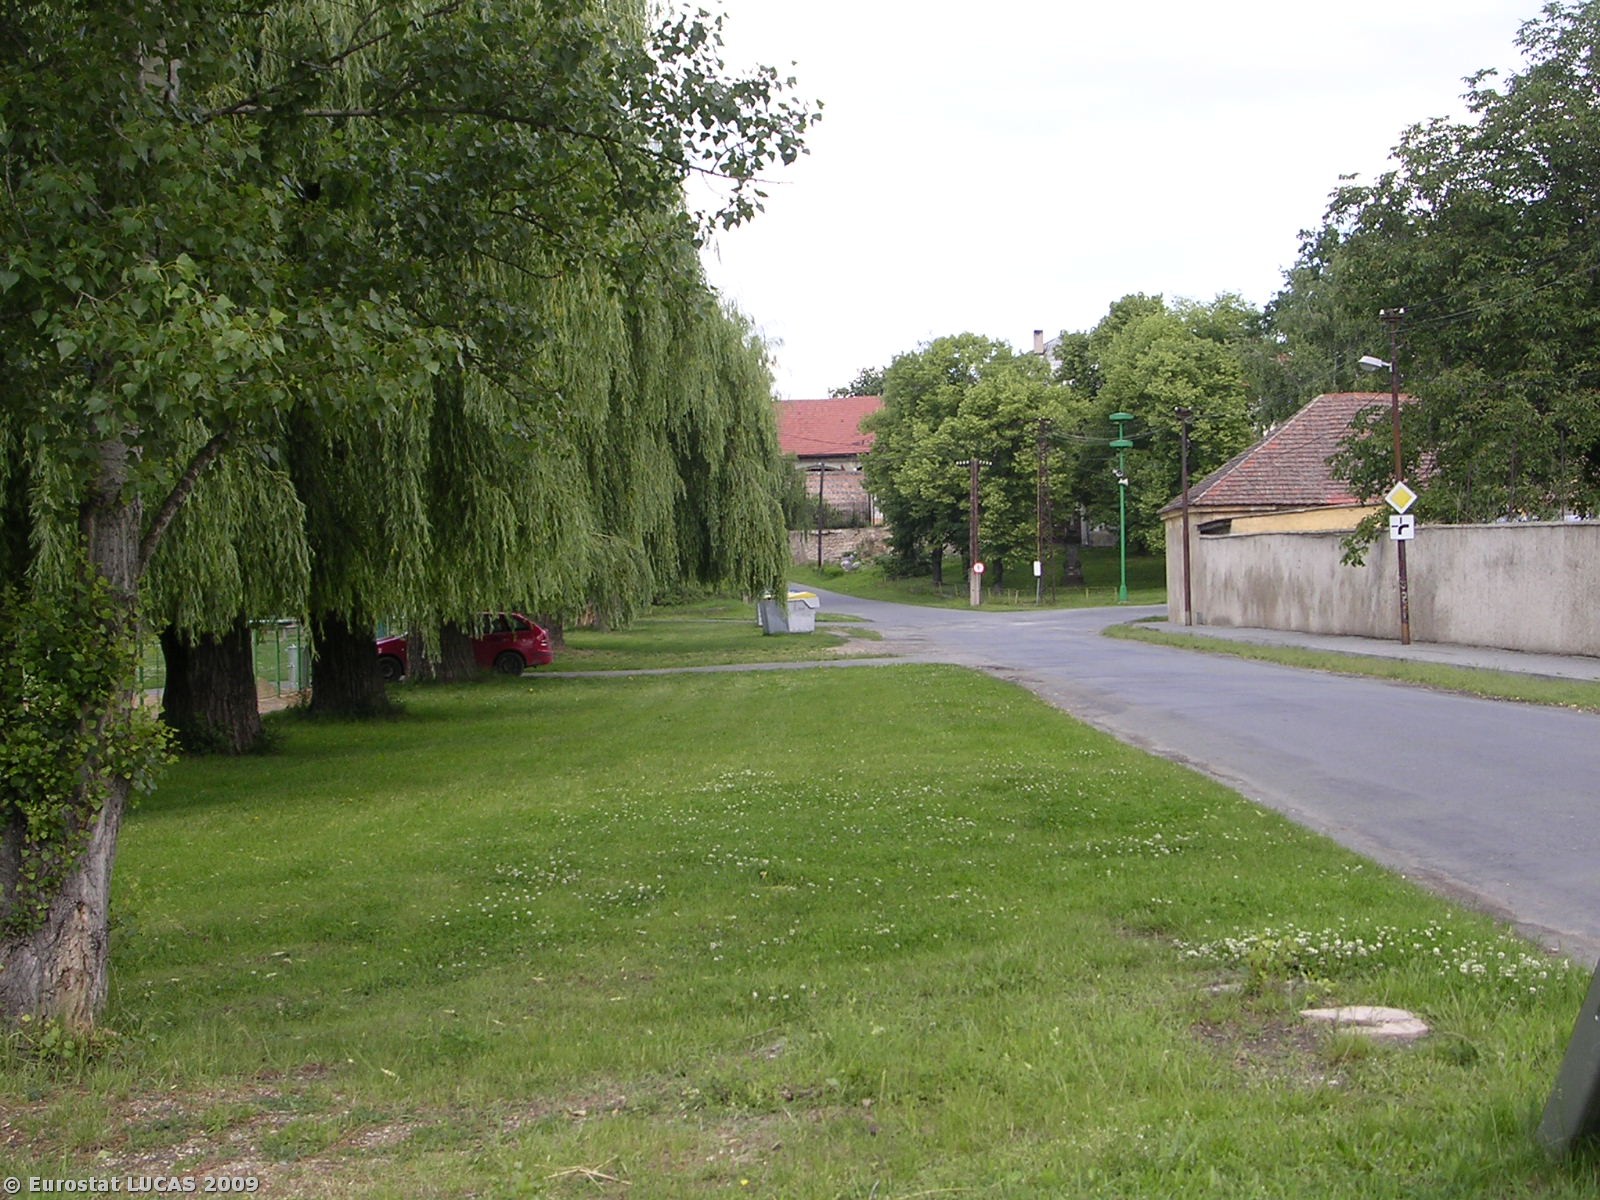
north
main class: Grassland
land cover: Grassland without tree/shrub cover
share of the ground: > 75 %
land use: Unused
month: May
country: CZ
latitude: 50.3060
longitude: 14.1713
